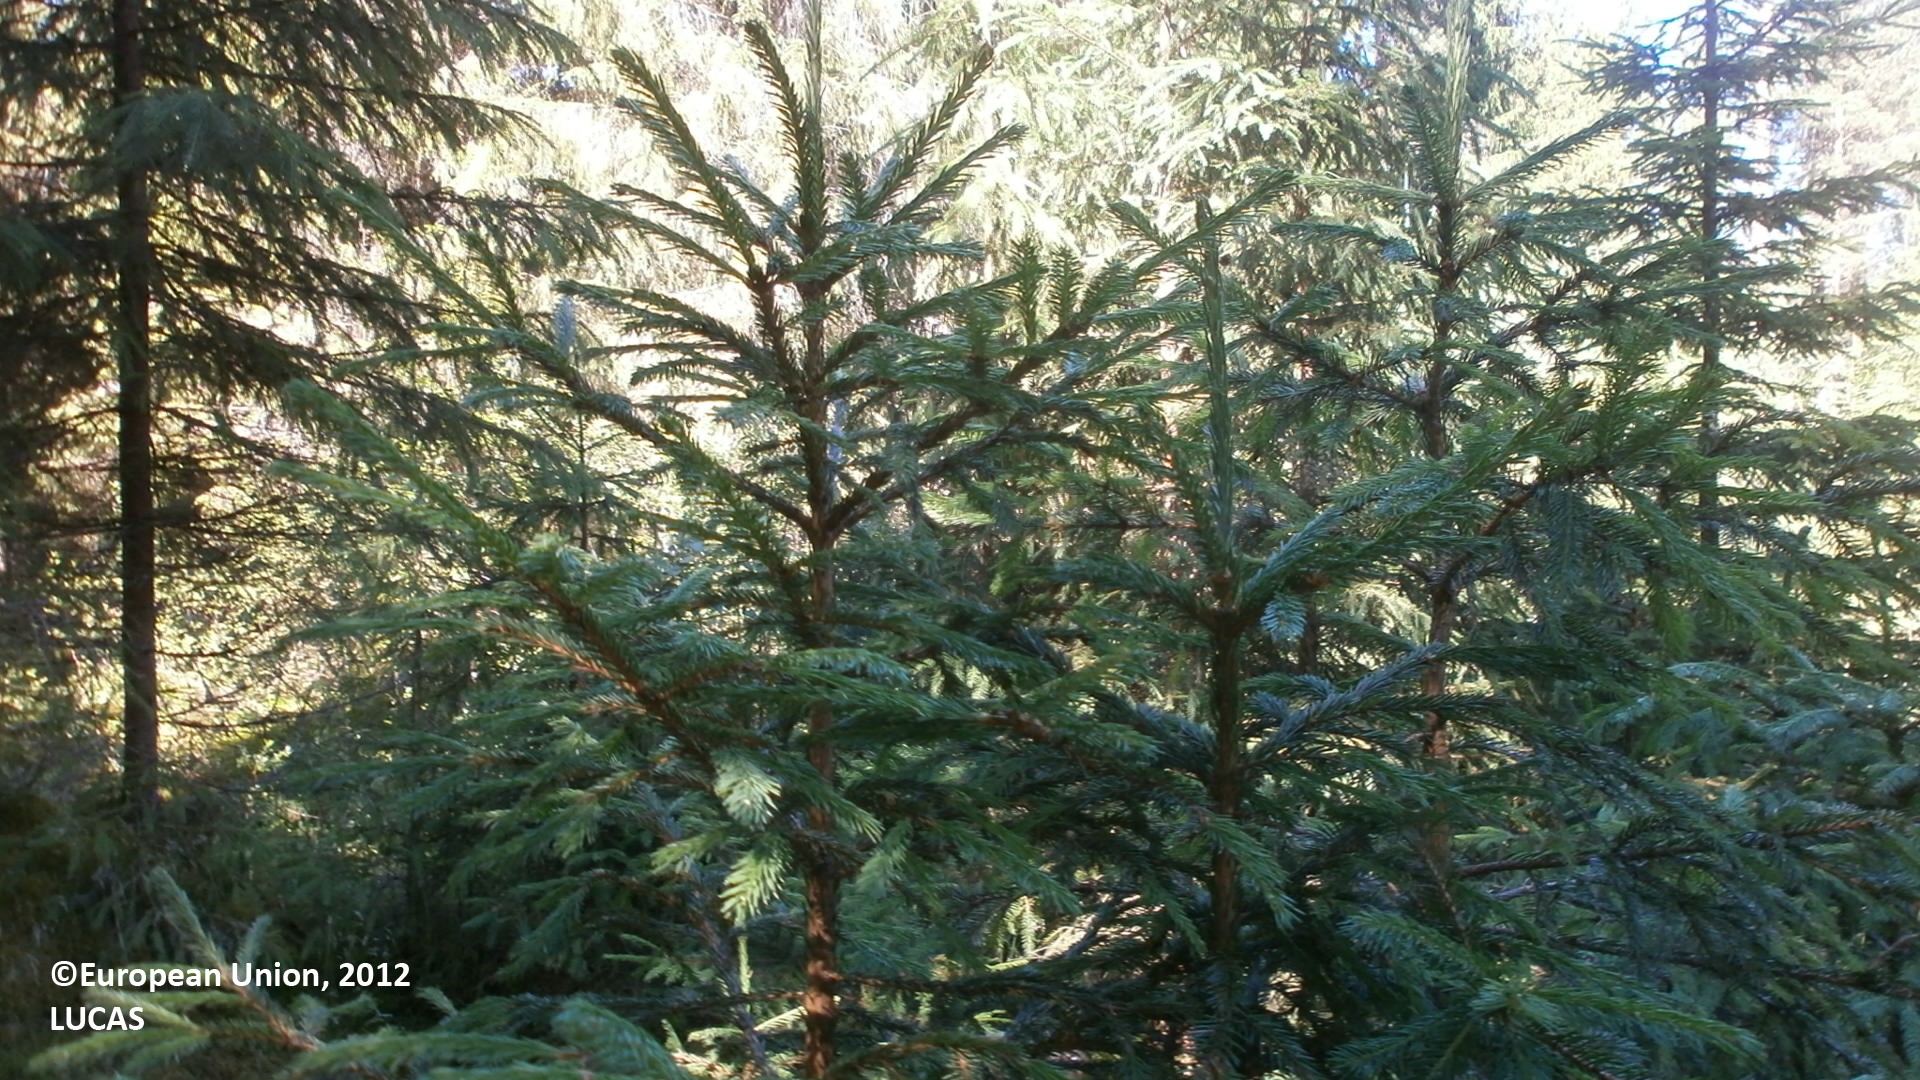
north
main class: Woodland
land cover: Spruce dominated coniferous woodland
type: boreal forest
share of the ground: 50 - 75 %
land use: Forestry
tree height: > 5 m
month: July
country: FI
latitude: 64.3375
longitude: 24.0741
